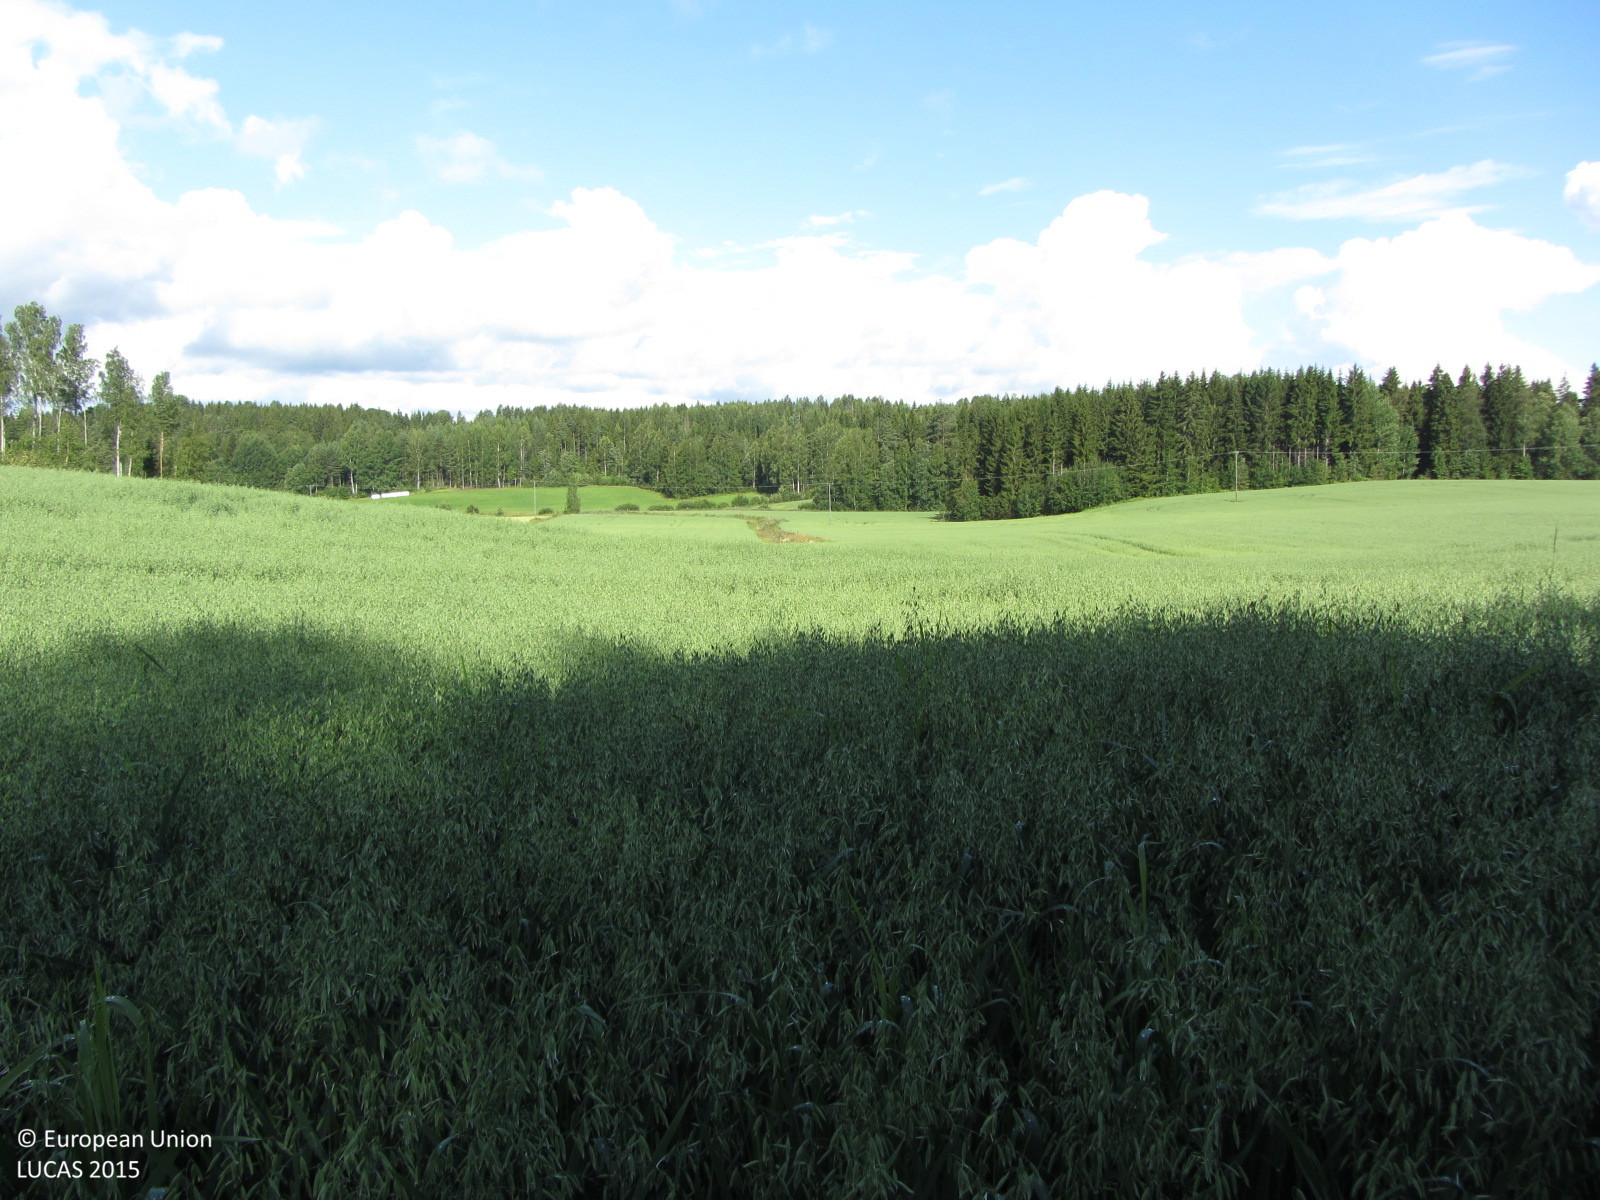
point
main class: Cropland
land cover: Oats
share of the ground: > 75 %
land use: Agriculture (excluding fallow land and kitchen gardens)
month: July
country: FI
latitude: 60.5082
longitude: 24.3247
